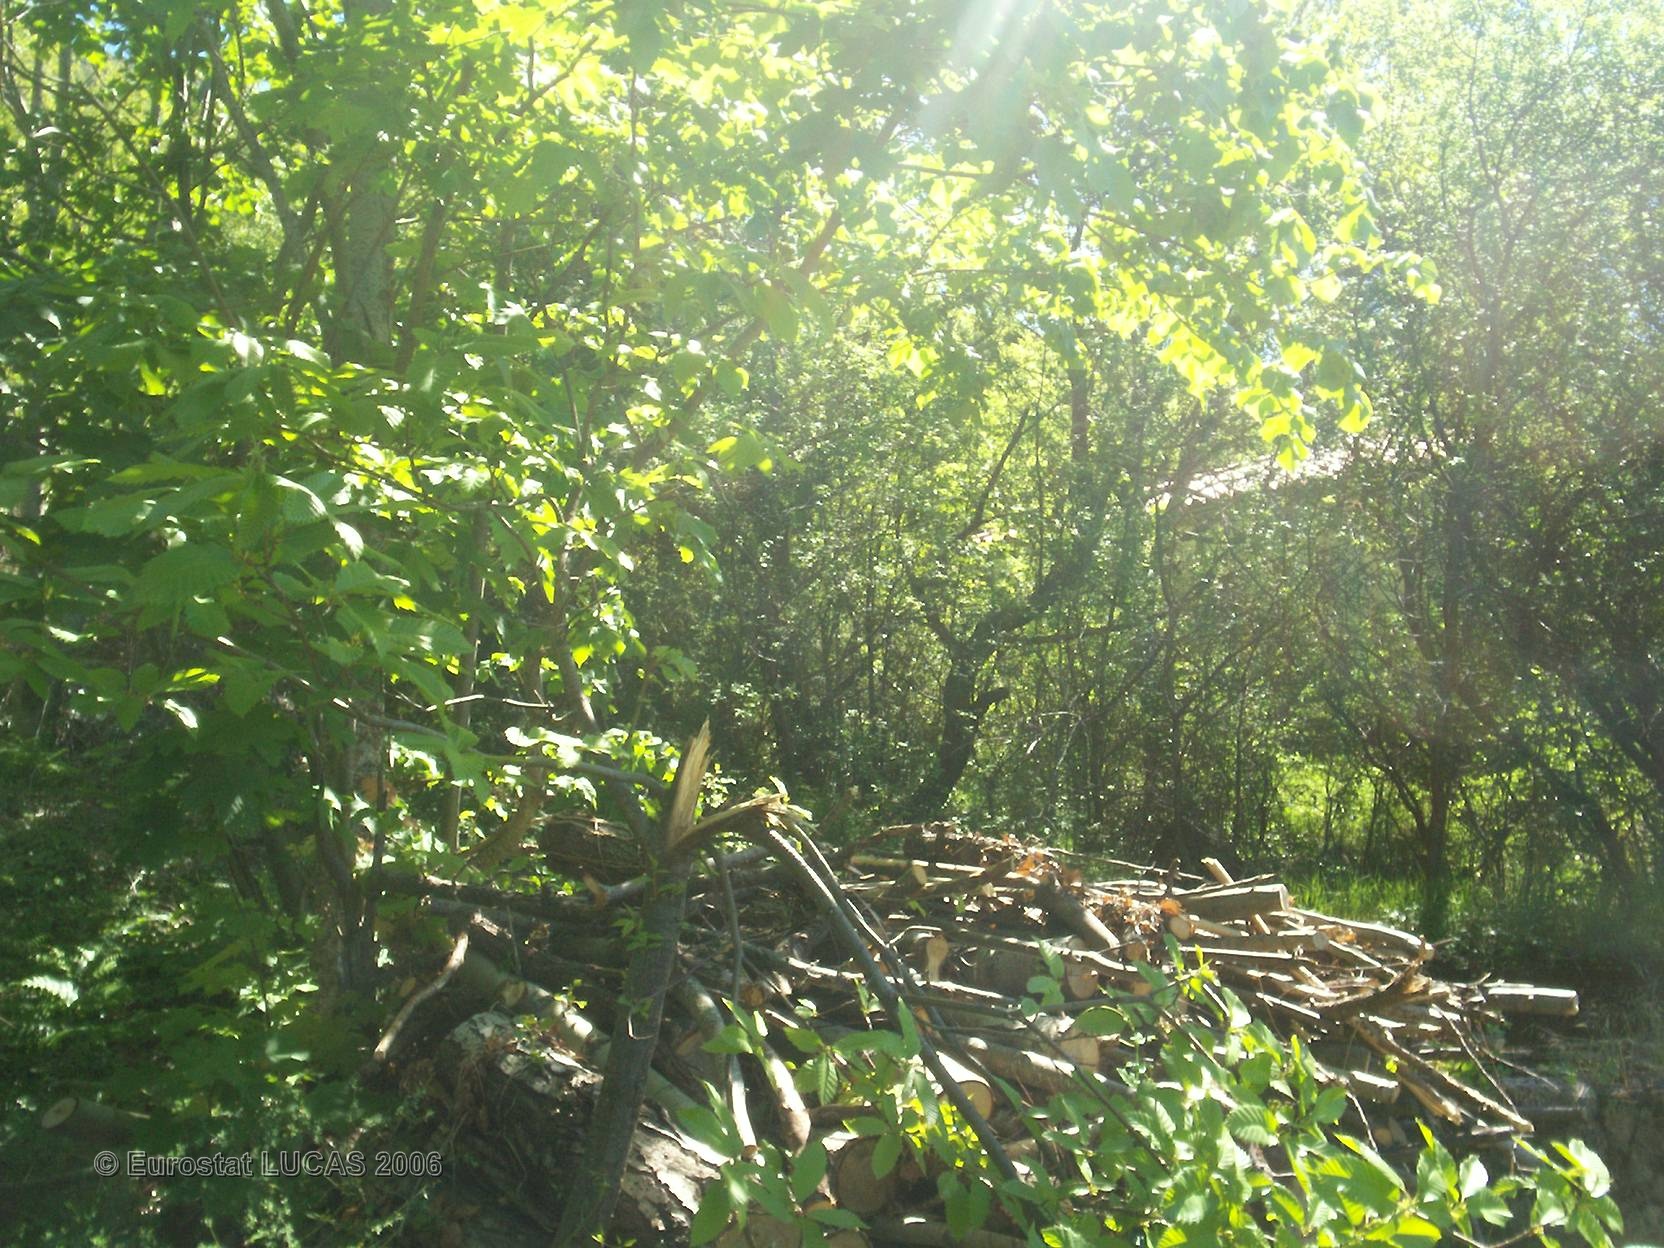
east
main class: Grassland
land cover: Grassland with sparse tree/shrub cover
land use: Residential
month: May
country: FR
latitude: 44.0010
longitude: 3.4848
